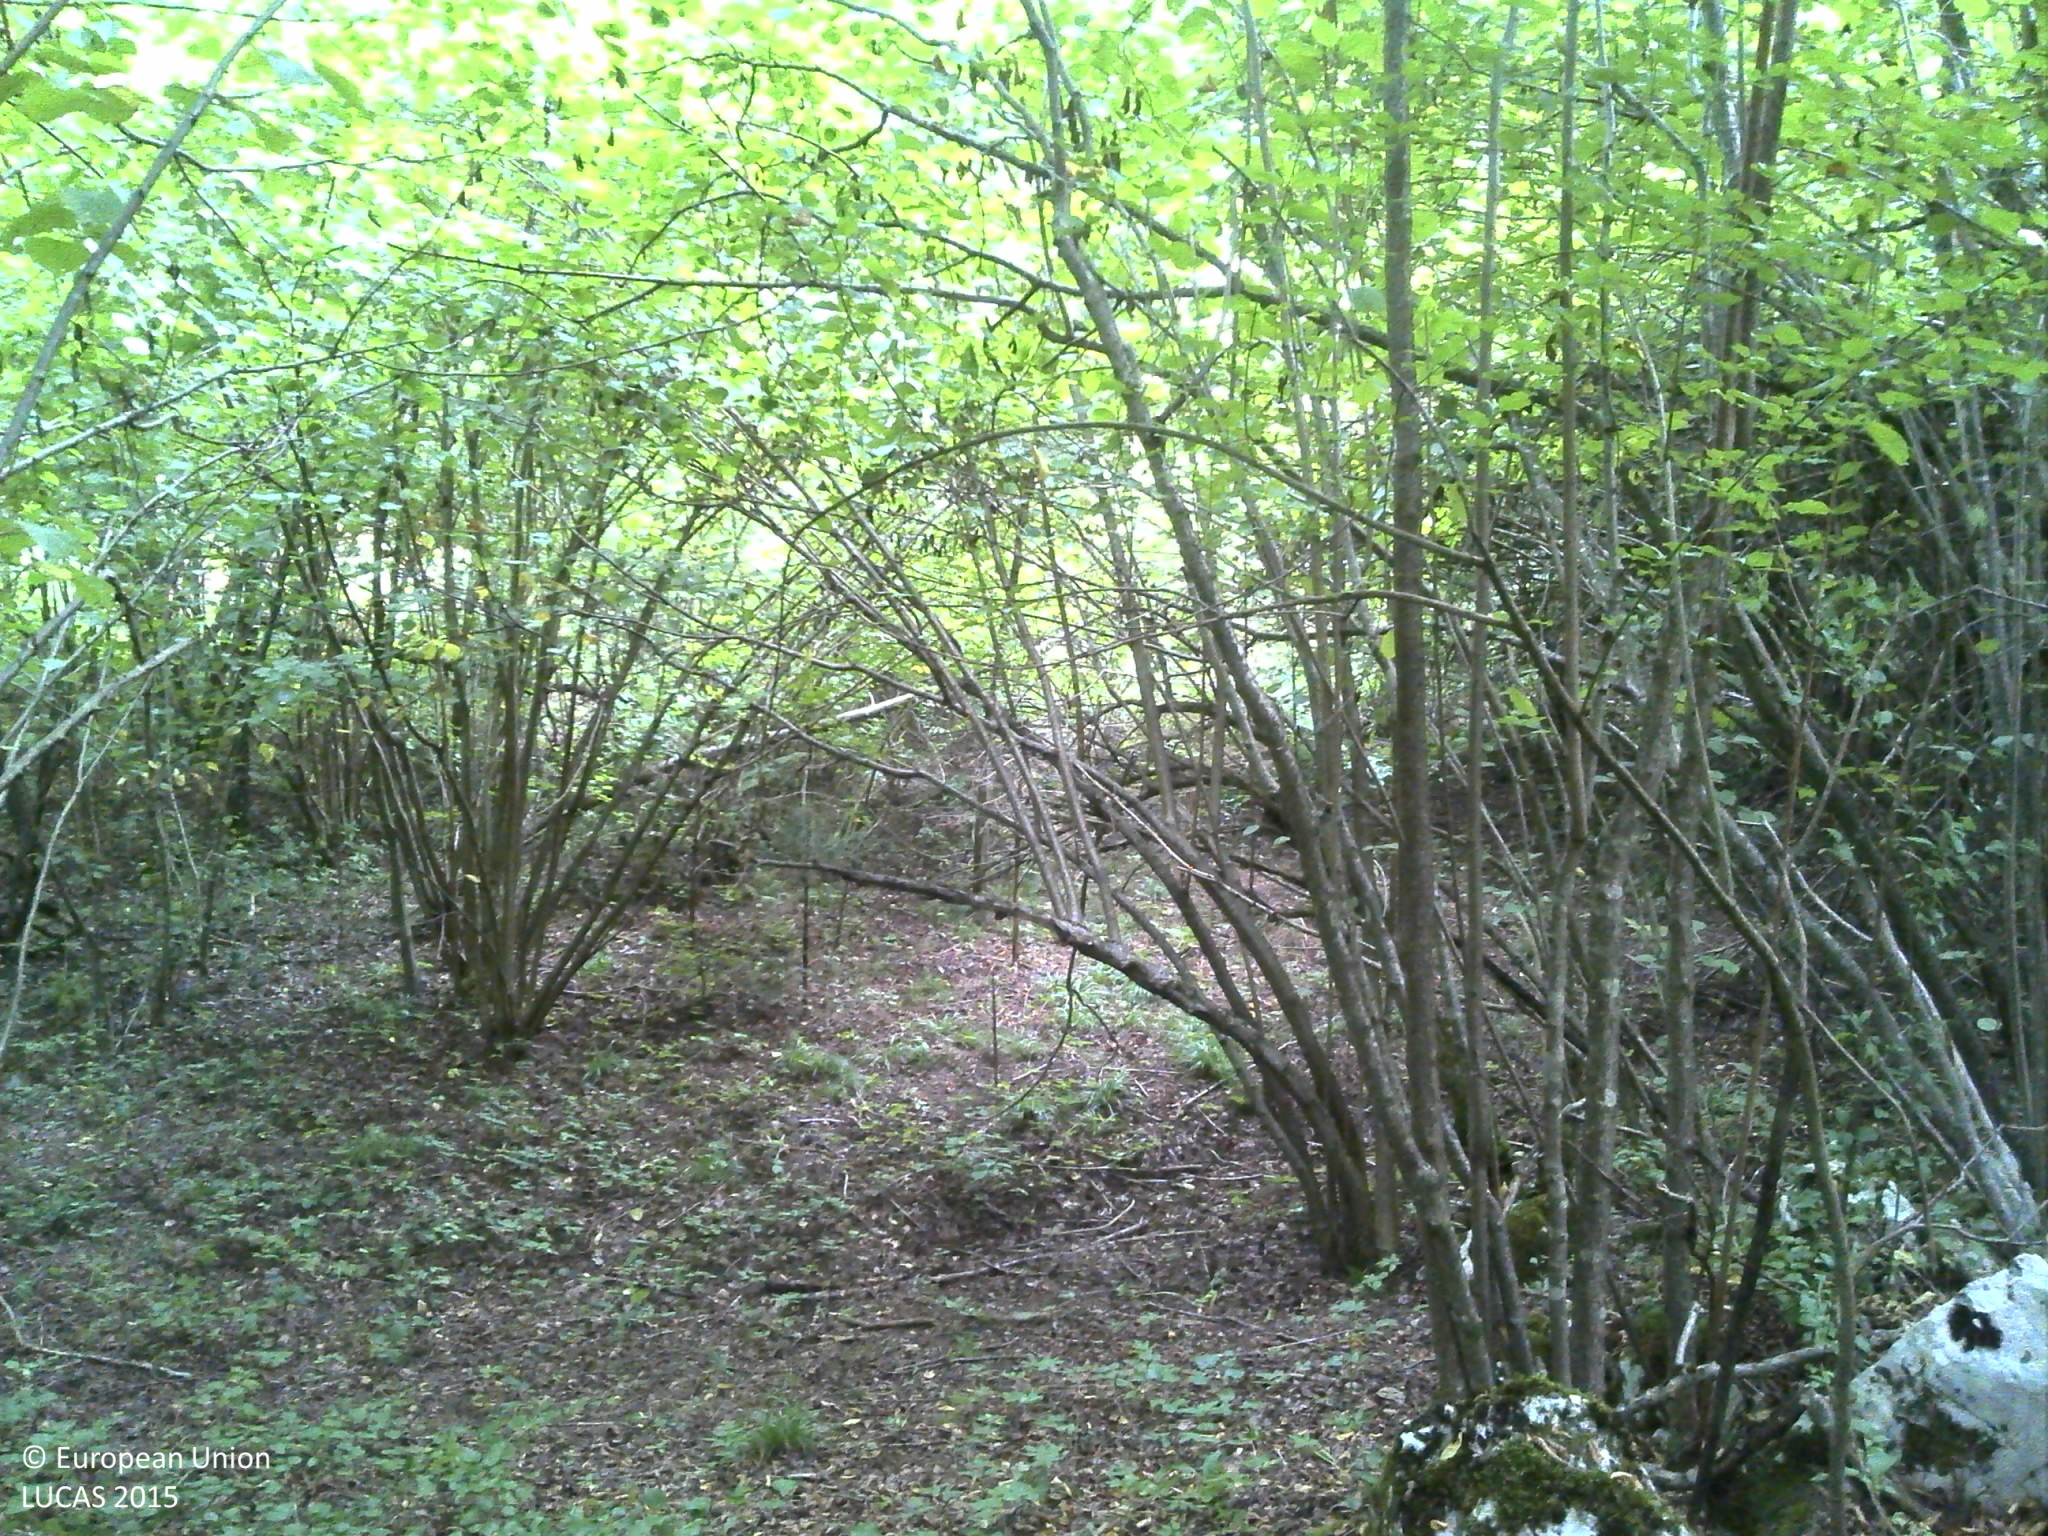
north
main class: Woodland
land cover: Broadleaved woodland
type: acidophilous oak and oak-birch forest
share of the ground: > 75 %
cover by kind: broadleaved forest trees 100 %
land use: Forestry
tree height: > 5 m
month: September
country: HR
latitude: 45.4075
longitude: 15.2981
